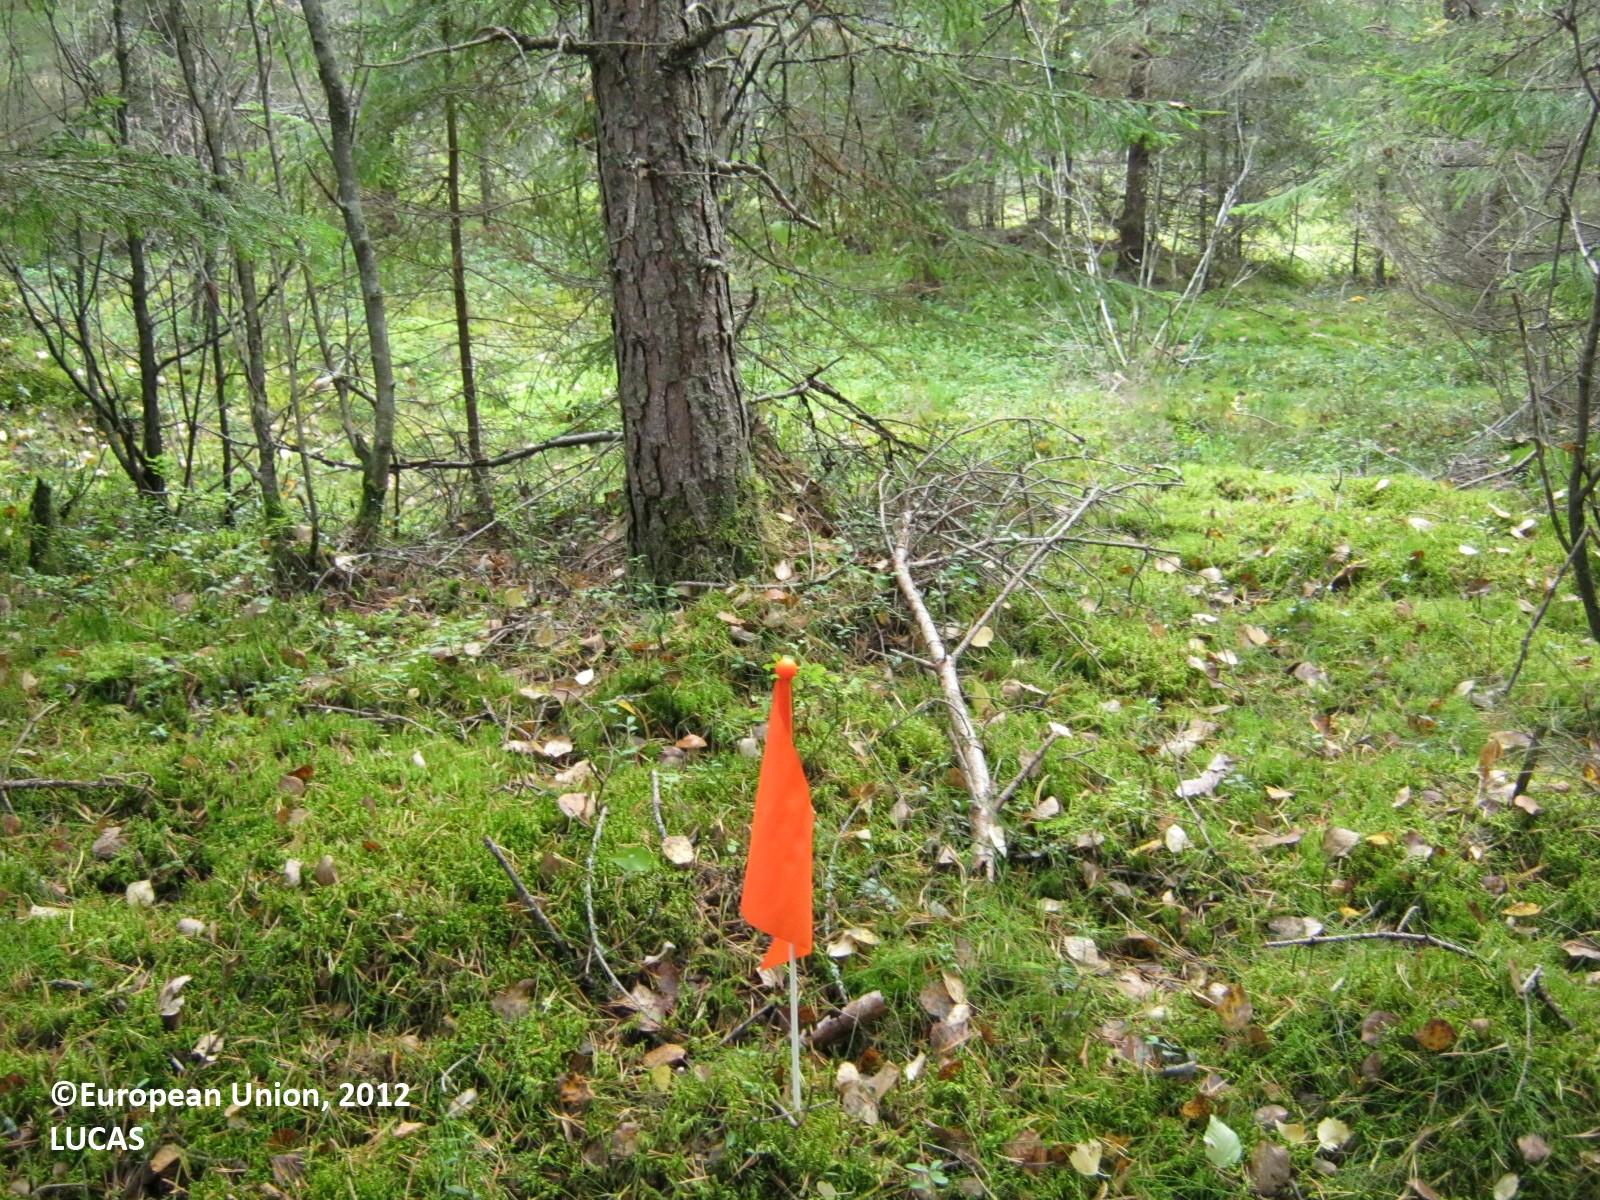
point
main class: Woodland
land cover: Other coniferous woodland
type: boreal forest
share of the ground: > 75 %
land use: Forestry
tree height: > 5 m
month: September
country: FI
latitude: 60.7108
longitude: 27.7290
